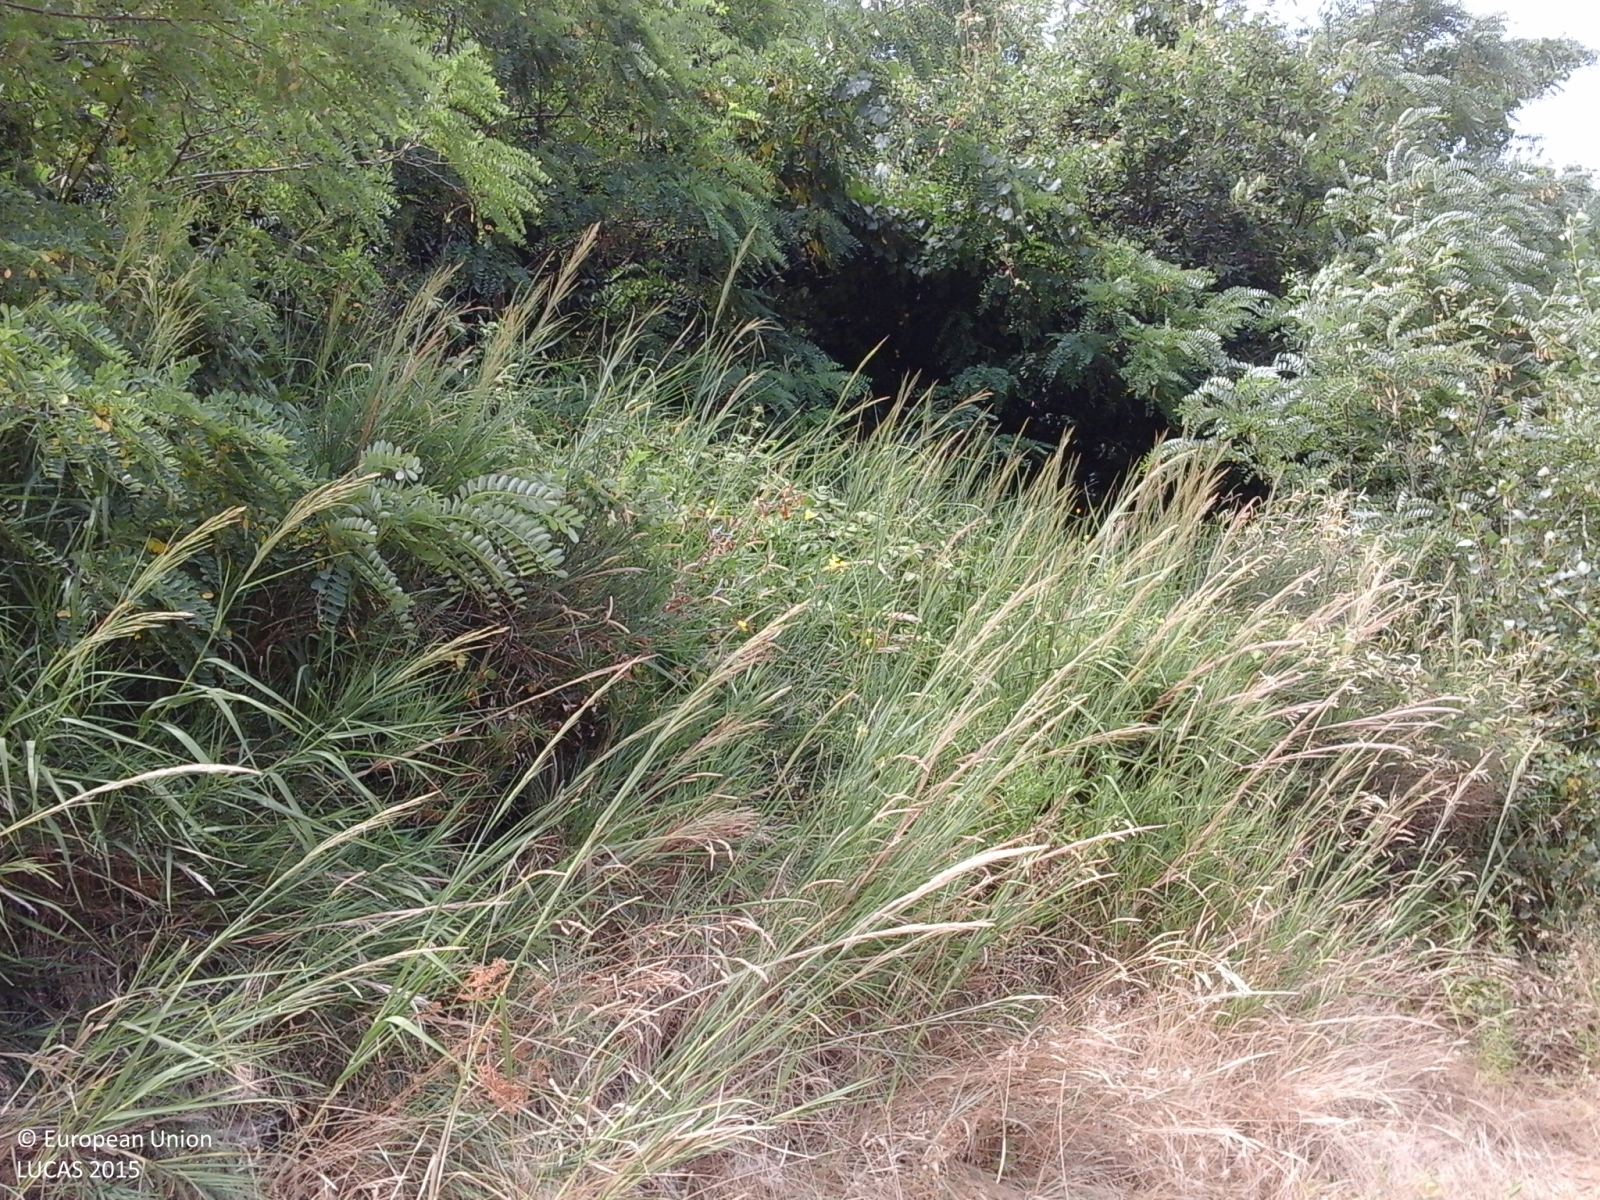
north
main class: Woodland
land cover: Broadleaved woodland
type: thermophilous deciduous forest
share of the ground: > 75 %
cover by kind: broadleaved forest trees 100 %
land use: Semi-natural and natural areas not in use
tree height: > 5 m
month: July
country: IT
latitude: 43.9030
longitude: 12.5960
